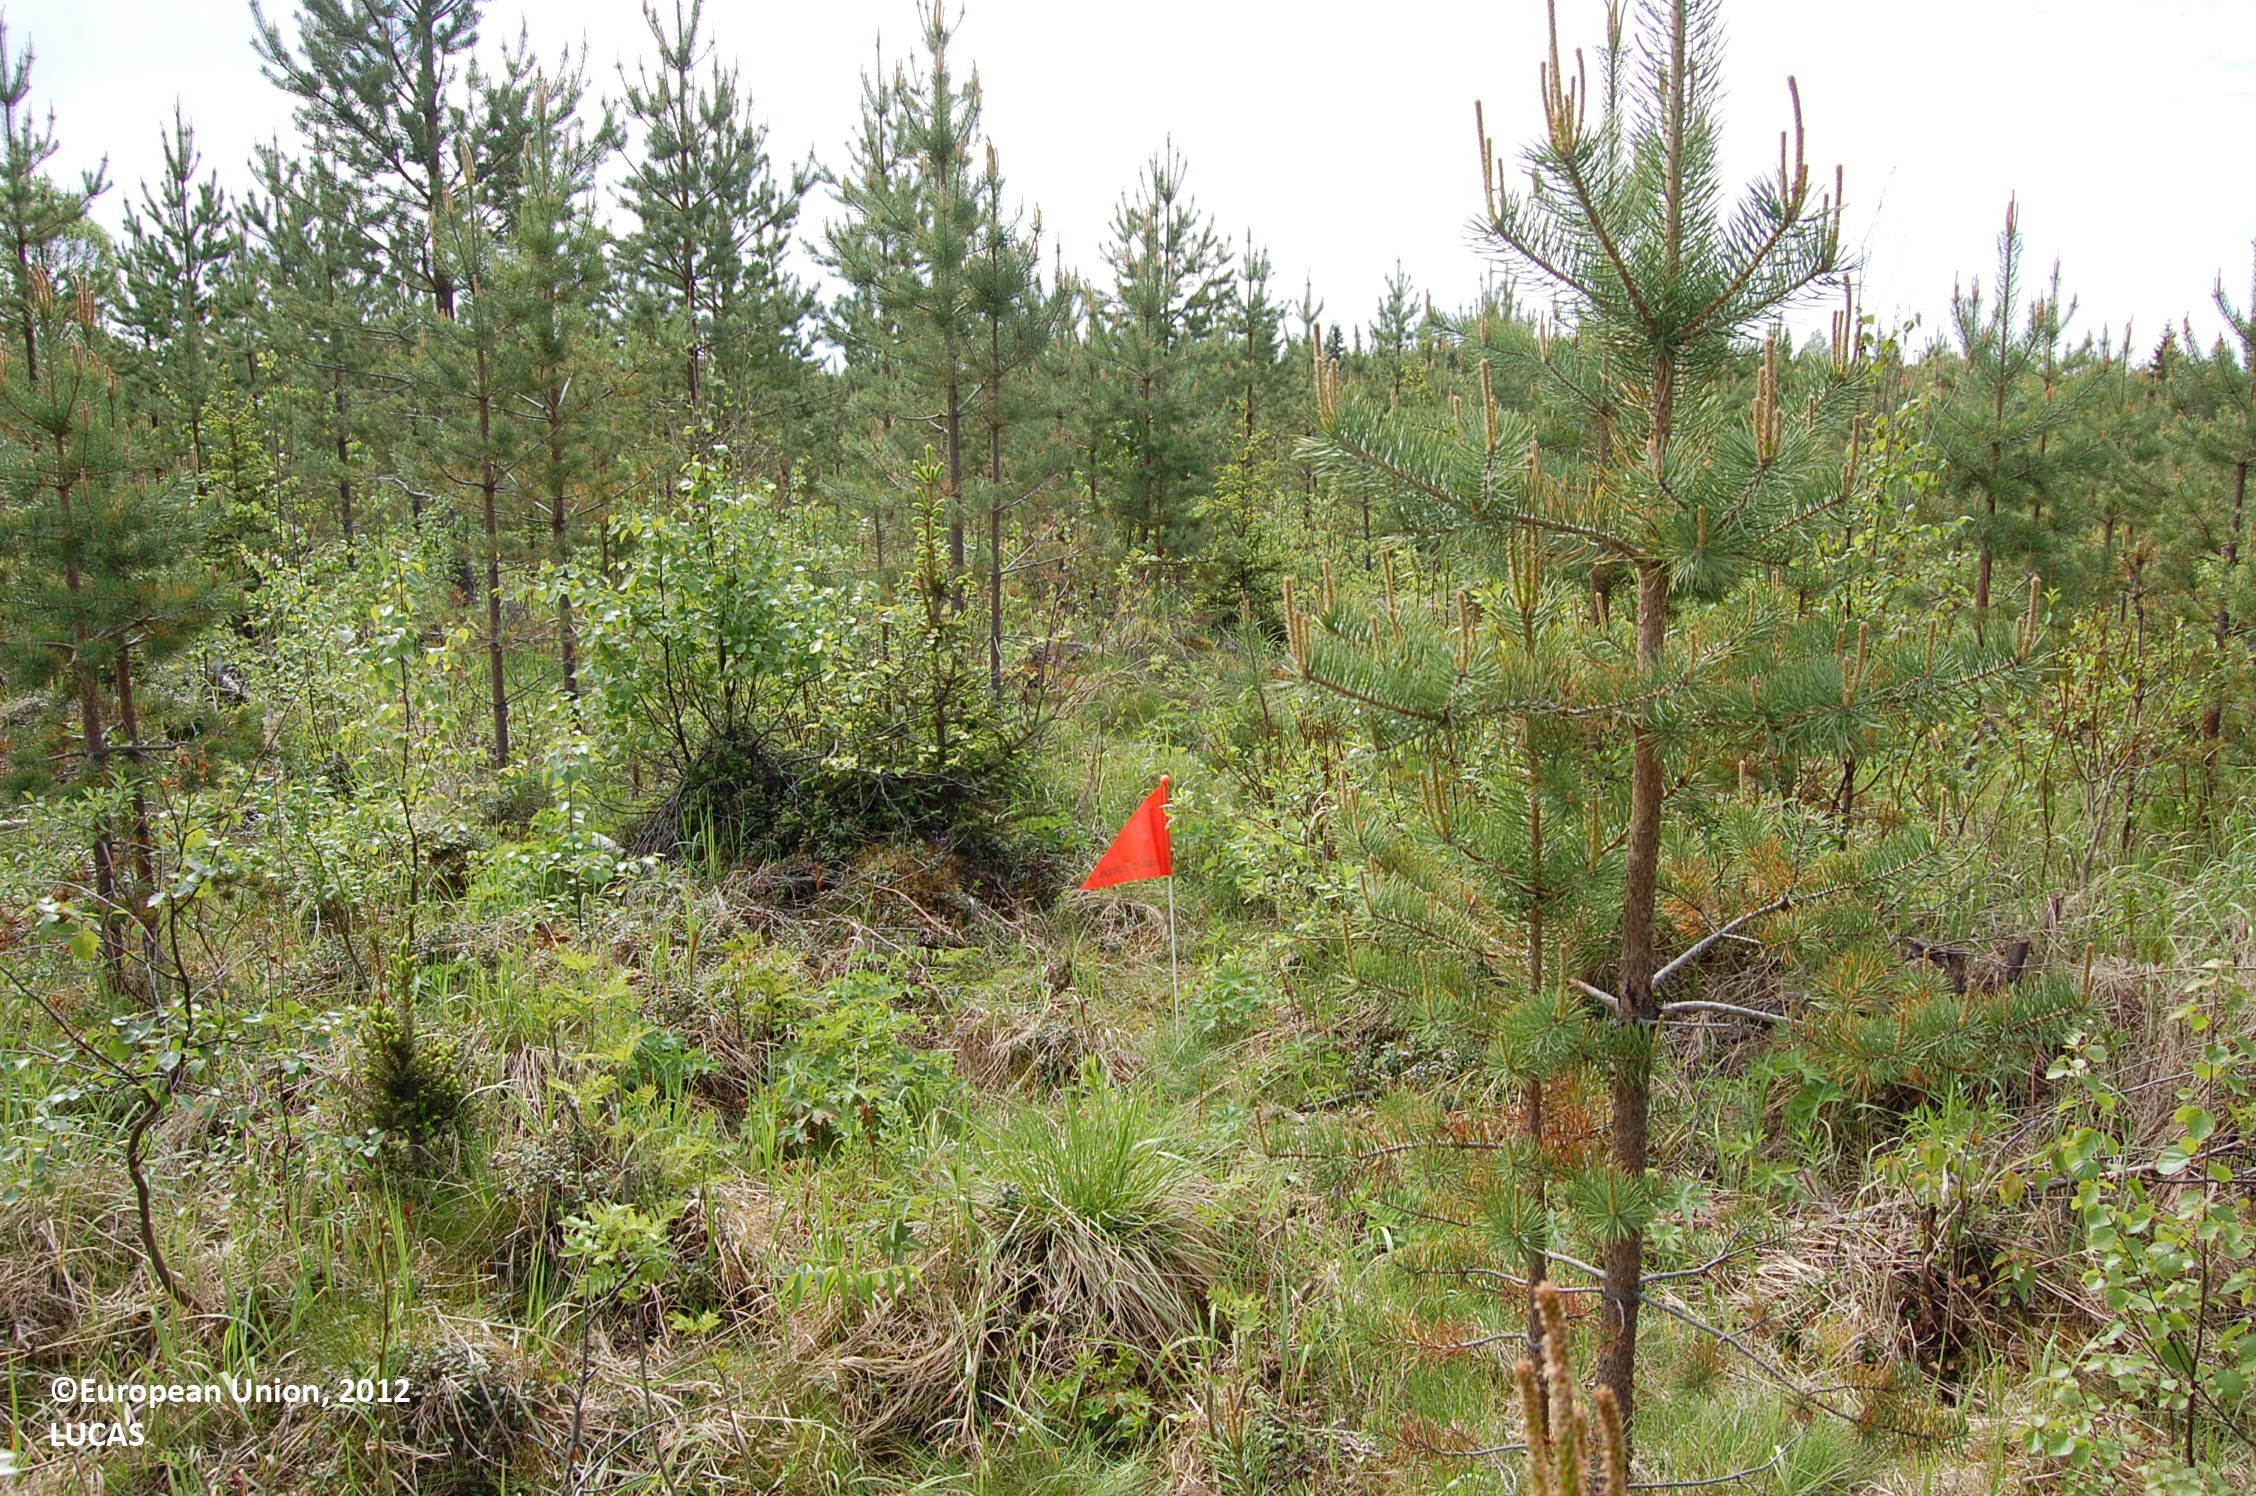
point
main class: Woodland
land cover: Pine dominated coniferous woodland
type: hemiboreal forest and nemoral coniferous forest and mixed broadleaved-coniferous forest
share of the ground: 25 - 50 %
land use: Forestry
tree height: < 5 m
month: June
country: FI
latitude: 63.9787
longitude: 26.0658
